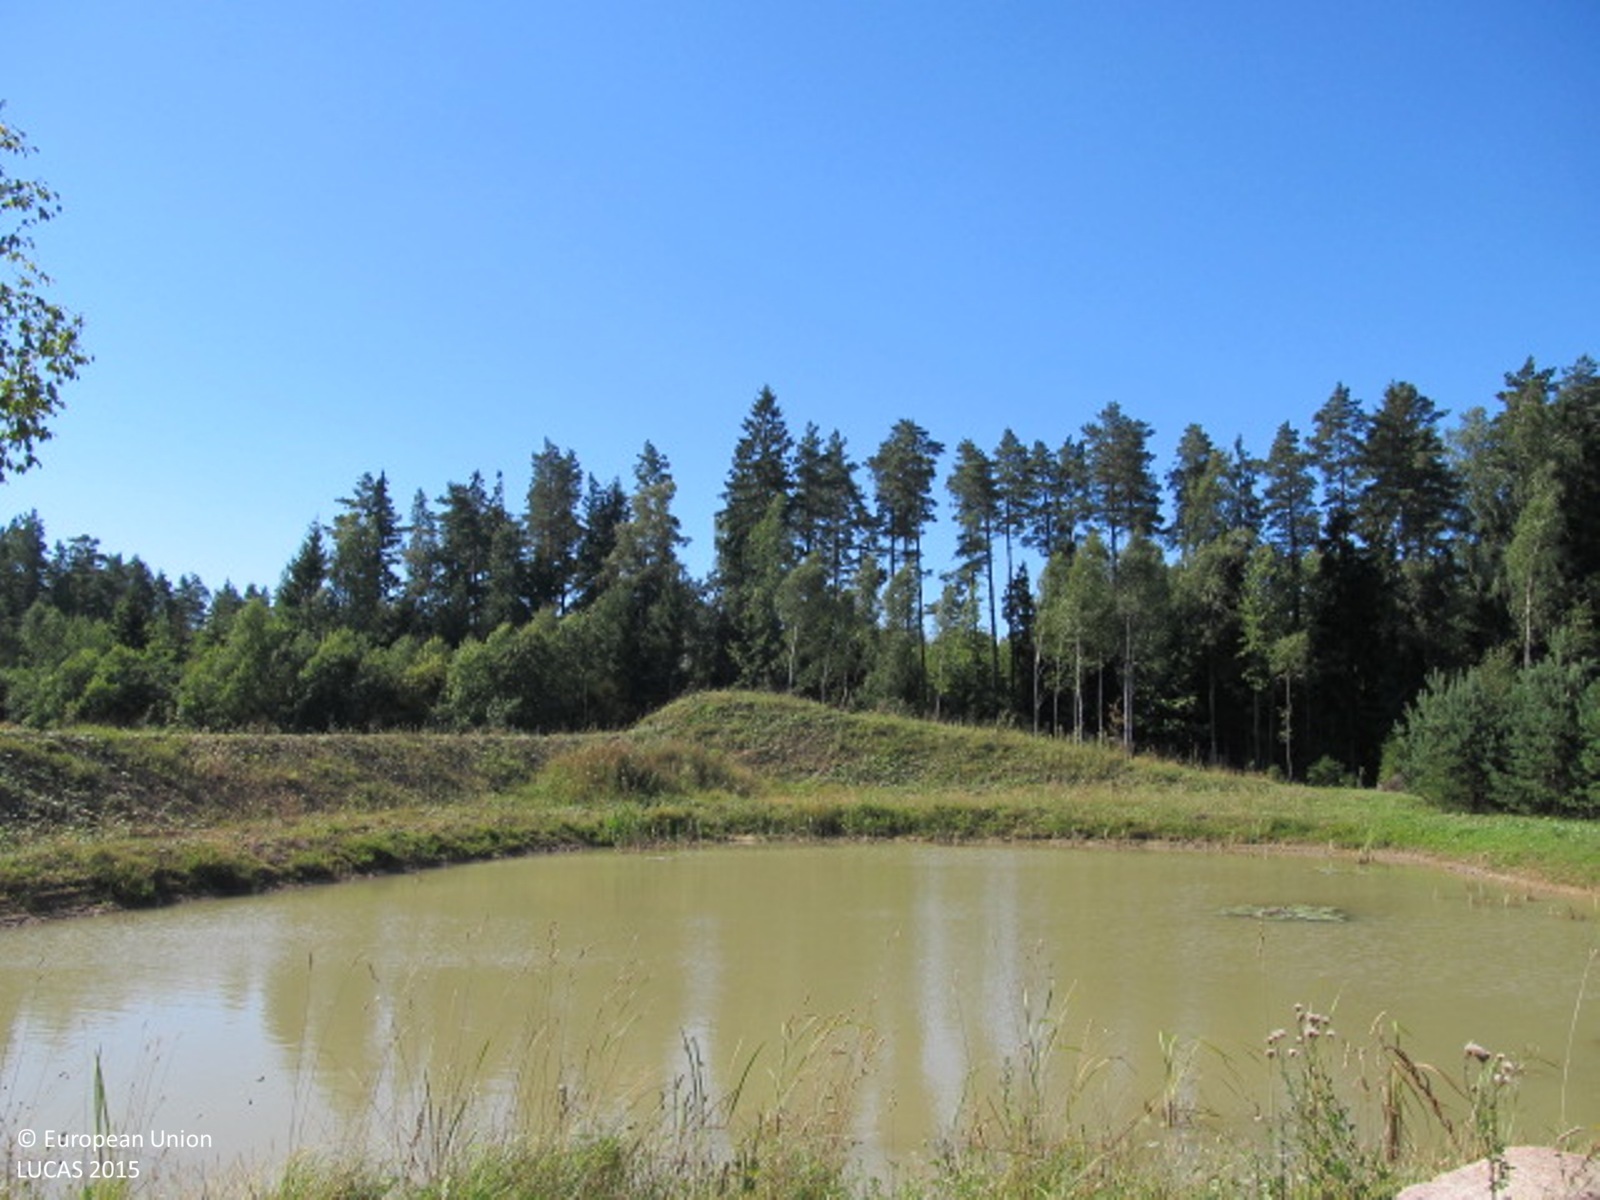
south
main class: Grassland
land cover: Spontaneously vegetated surfaces
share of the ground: 50 - 75 %
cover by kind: herbaceous plants 50 %, unconsolidated bare surface 45 %
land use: Amenities, museums, leisure
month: August
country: LT
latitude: 56.3099
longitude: 22.4226
